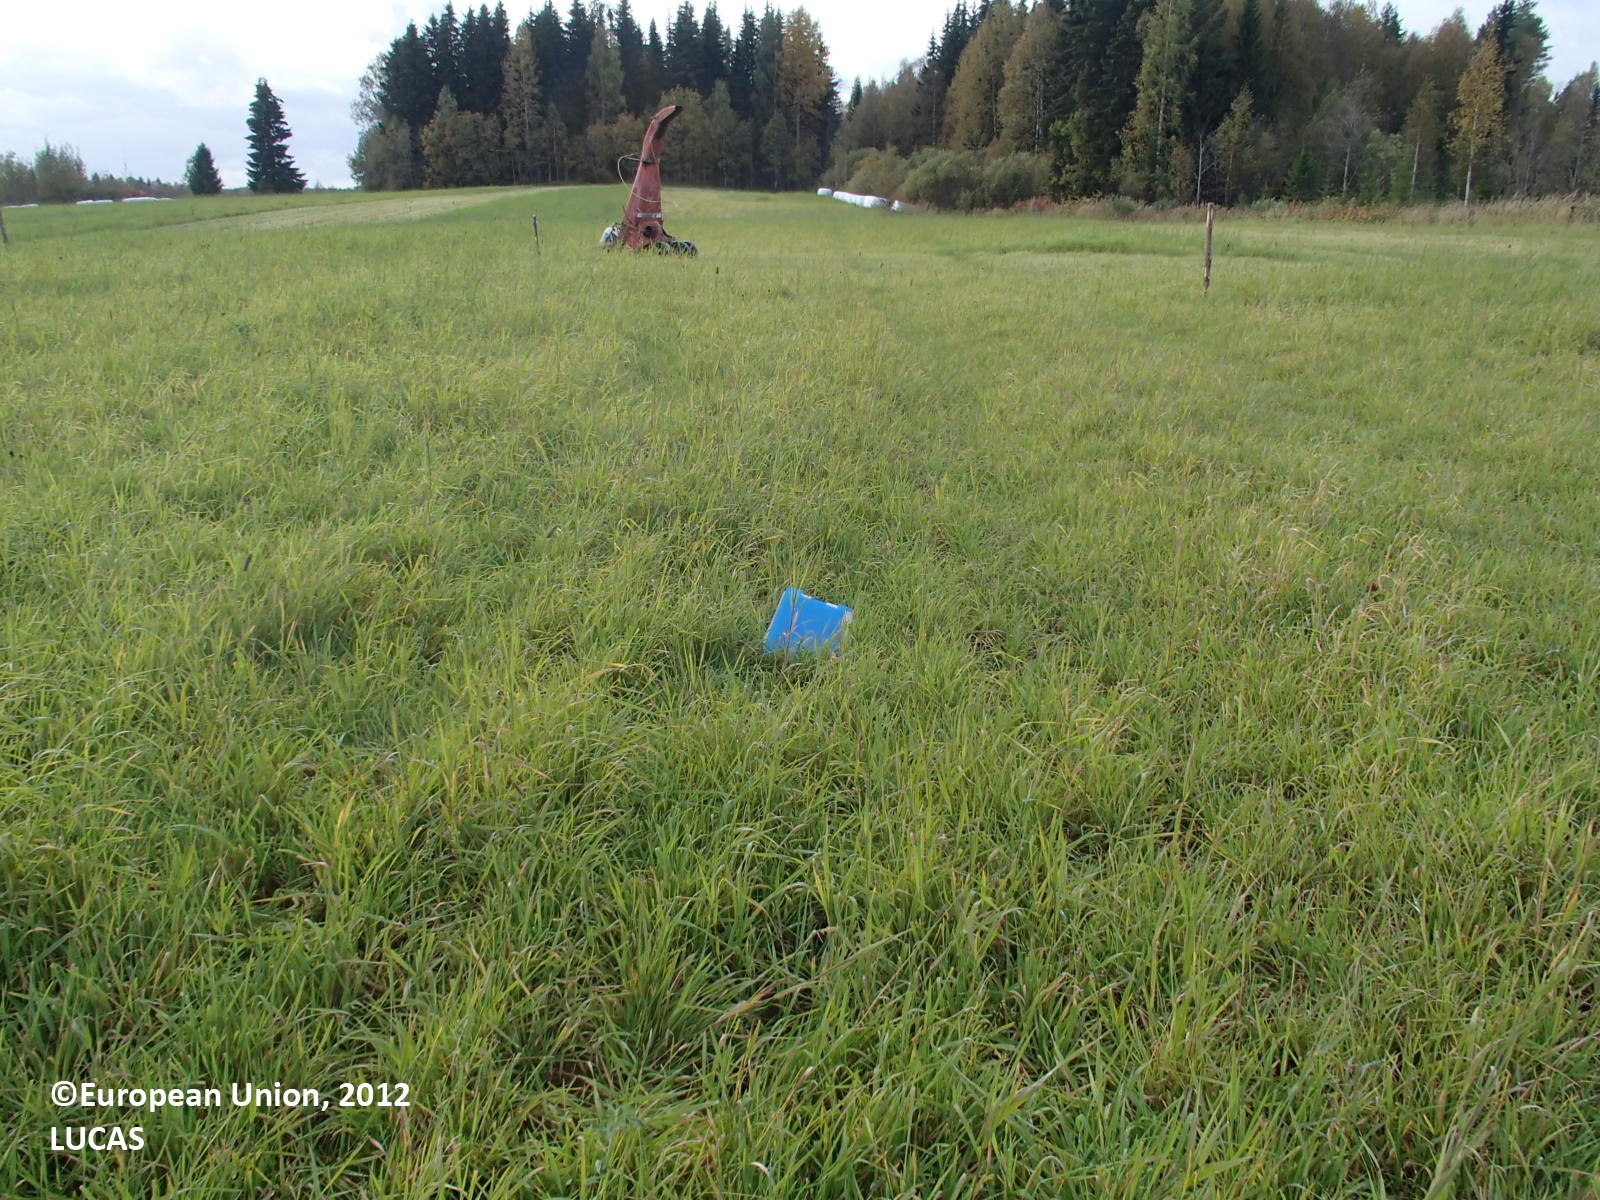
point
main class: Cropland
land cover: Temporary grasslands
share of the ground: > 75 %
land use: Agriculture (excluding fallow land and kitchen gardens)
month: September
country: FI
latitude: 63.3047
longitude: 27.9498
